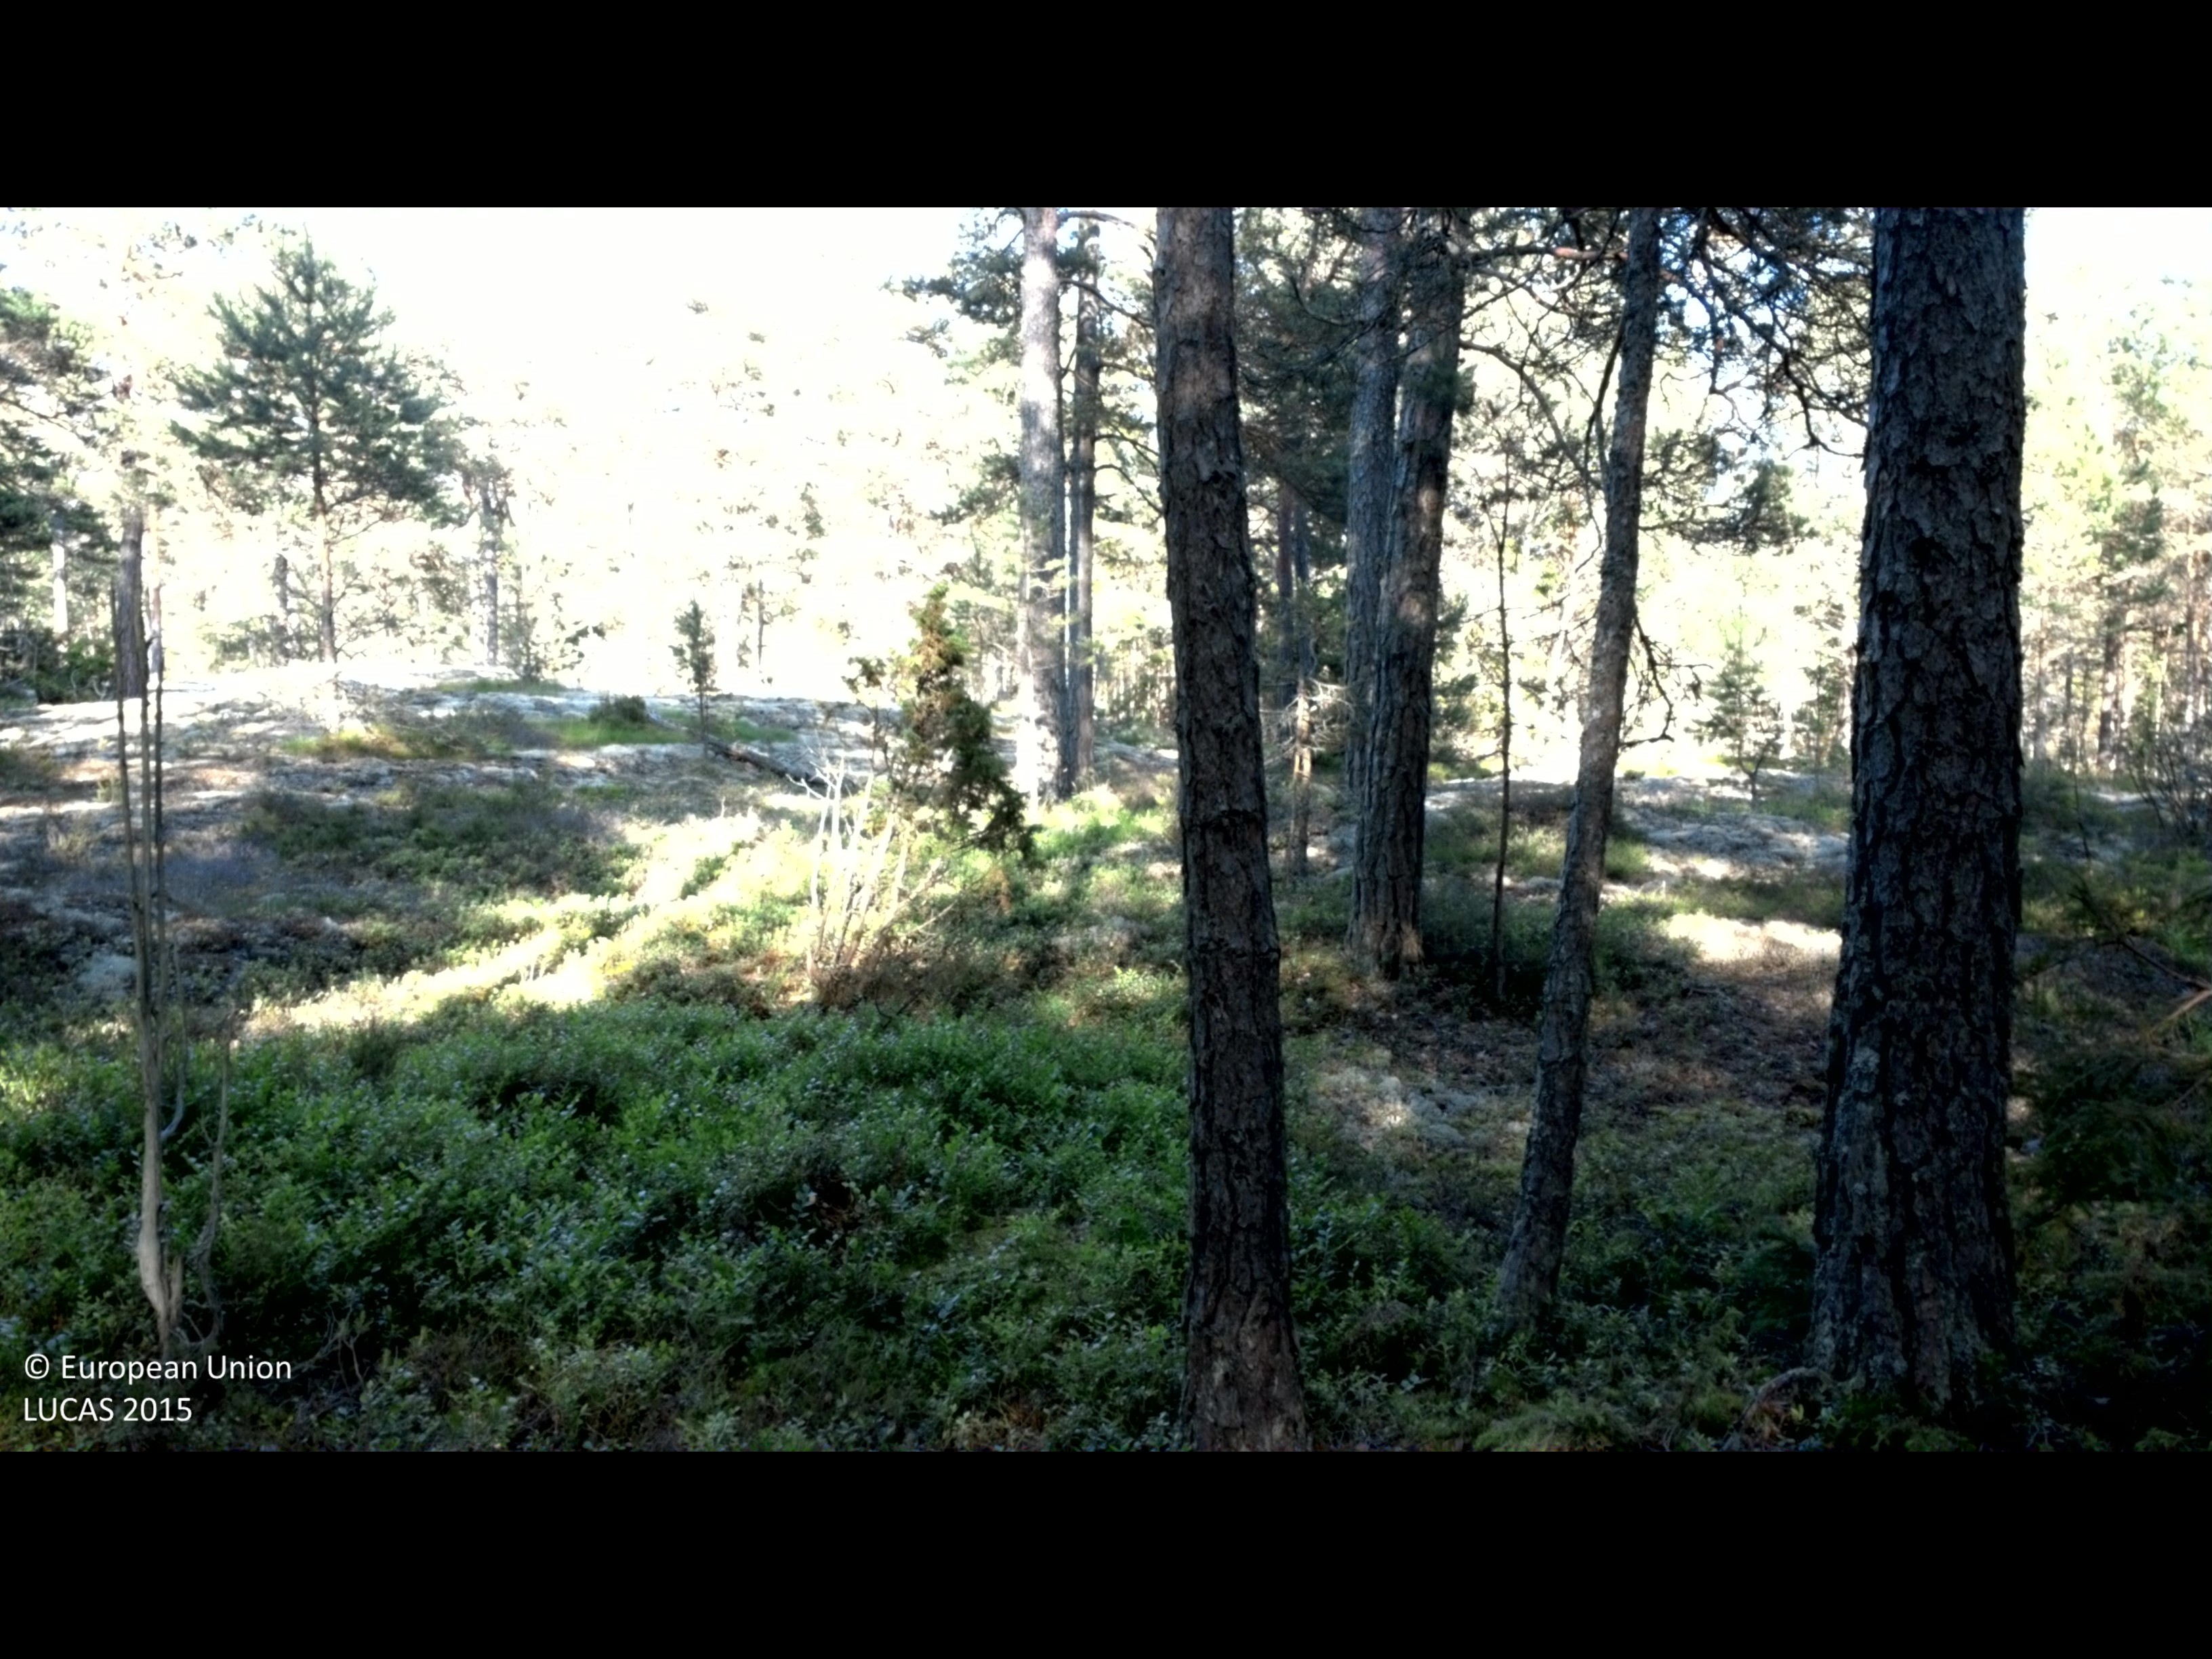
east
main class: Woodland
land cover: Pine dominated coniferous woodland
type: boreal forest
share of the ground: > 75 %
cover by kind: coniferous forest trees 65 %, broadleaved forest trees 15 %, shrubs 15 %, lichens and mosses 5 %
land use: Forestry
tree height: > 5 m
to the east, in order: Pine dominated coniferous woodland; Rock outcrops; Pine dominated coniferous woodland; Rock outcrops; Pine dominated coniferous woodland
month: June
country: SE
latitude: 58.0171
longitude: 16.6845
